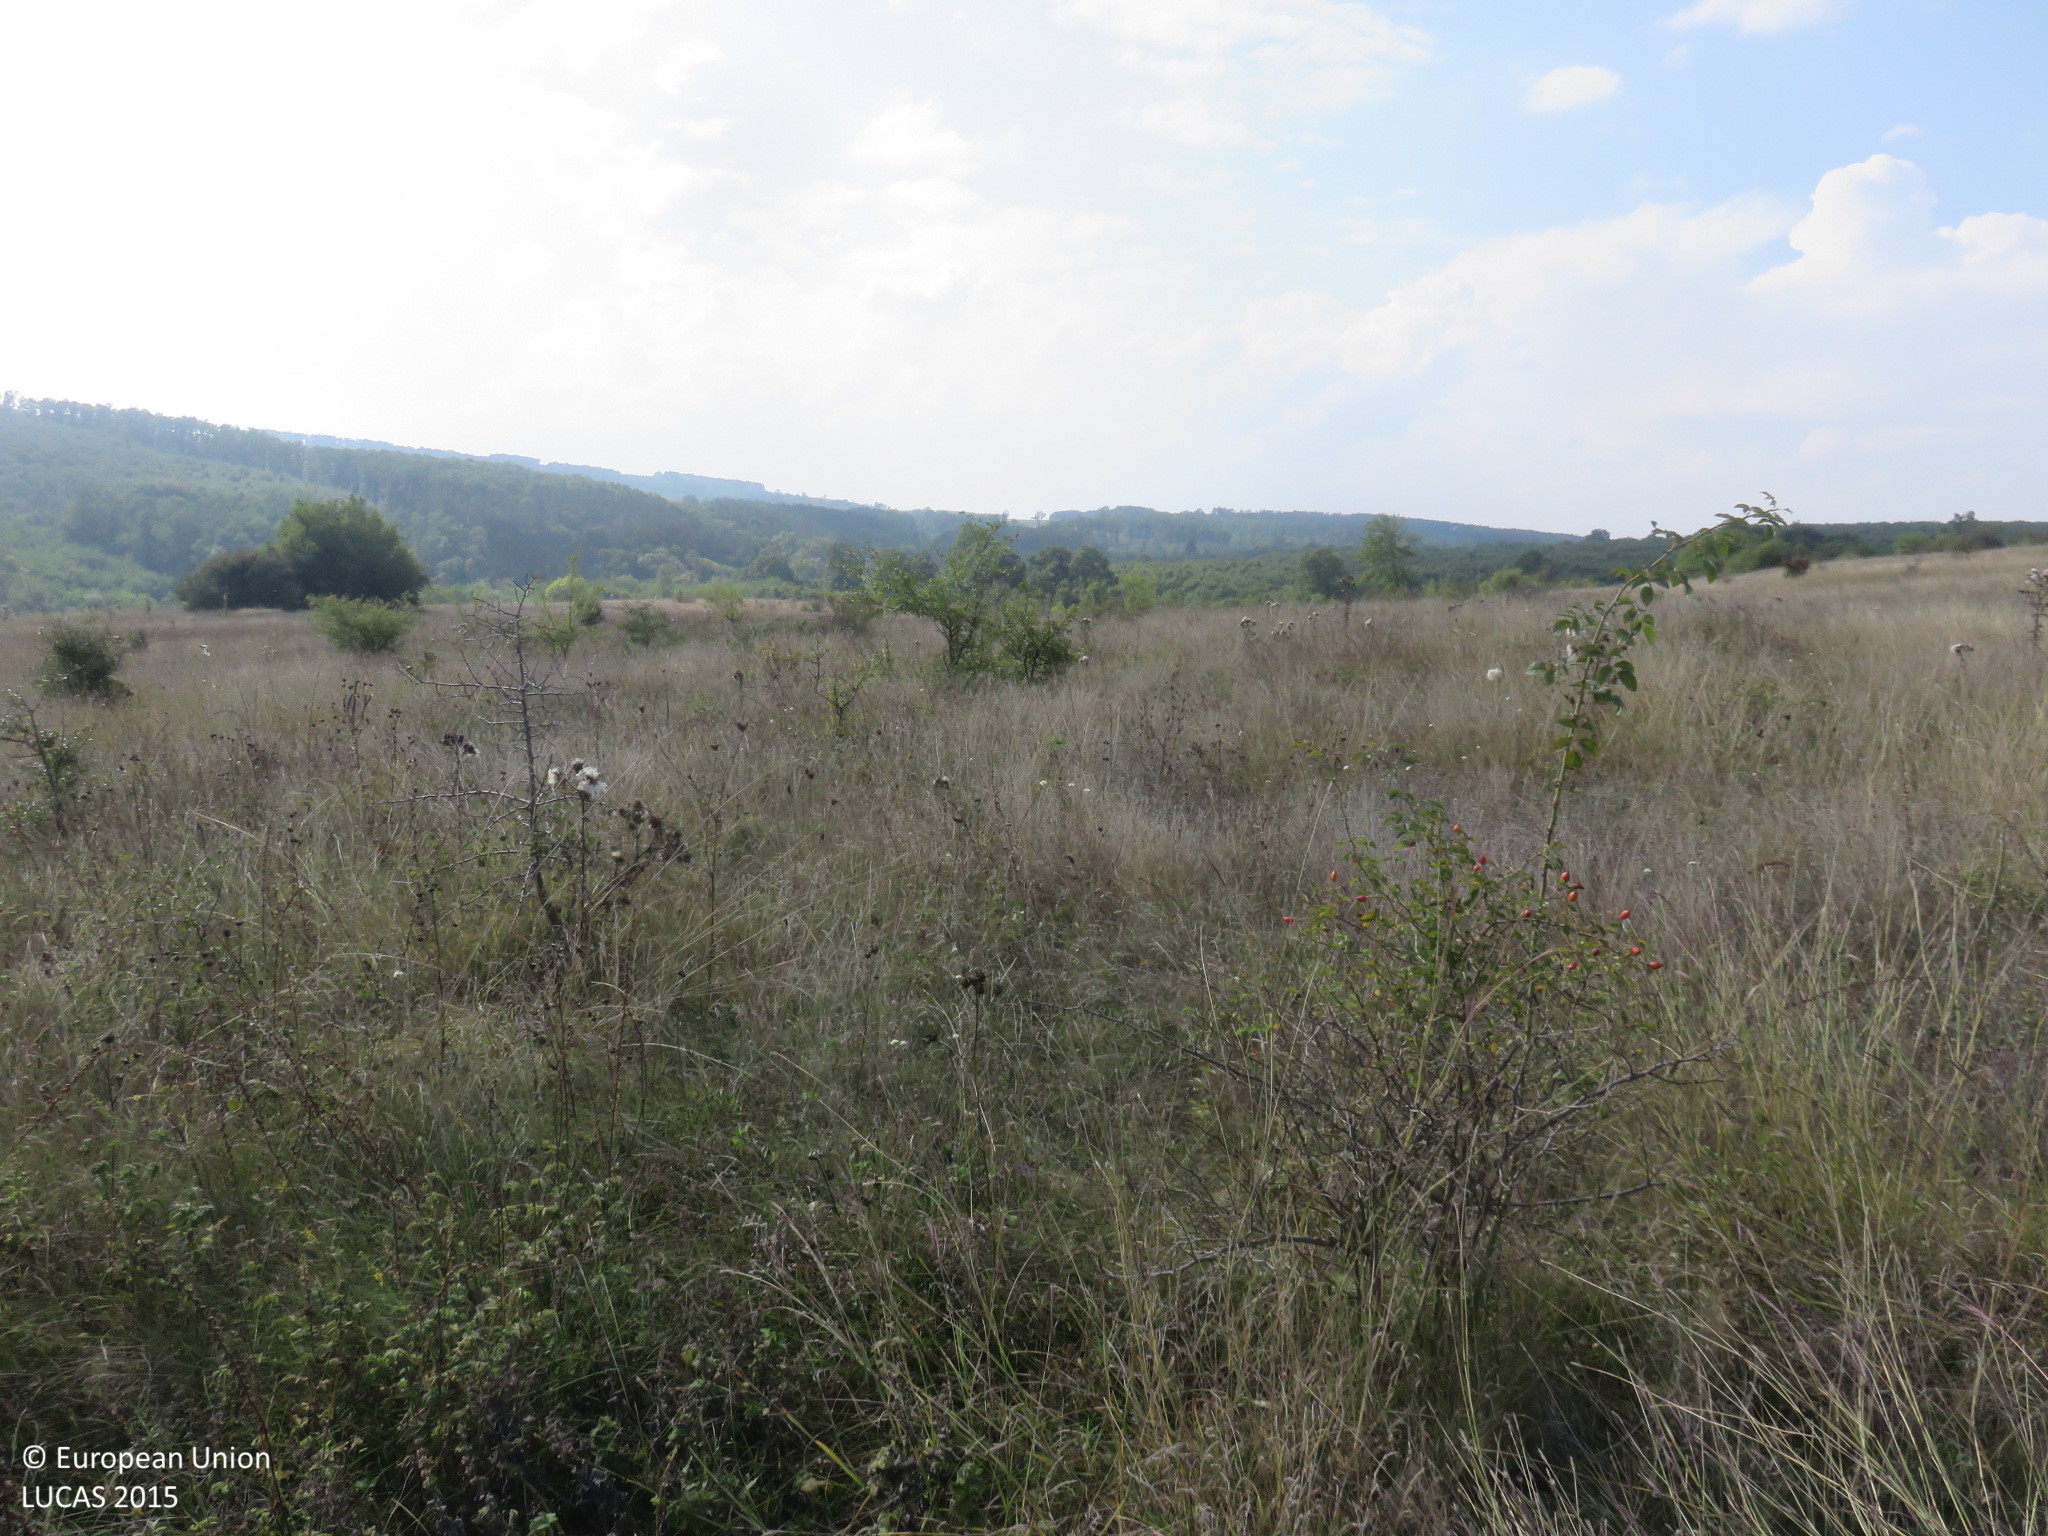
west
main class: Grassland
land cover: Grassland with sparse tree/shrub cover
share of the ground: > 75 %
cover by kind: herbaceous plants 90 %, broadleaved forest trees 5 %, shrubs 5 %
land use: Fallow land
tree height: < 5 m
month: September
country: BG
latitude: 43.1561
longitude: 25.0348
